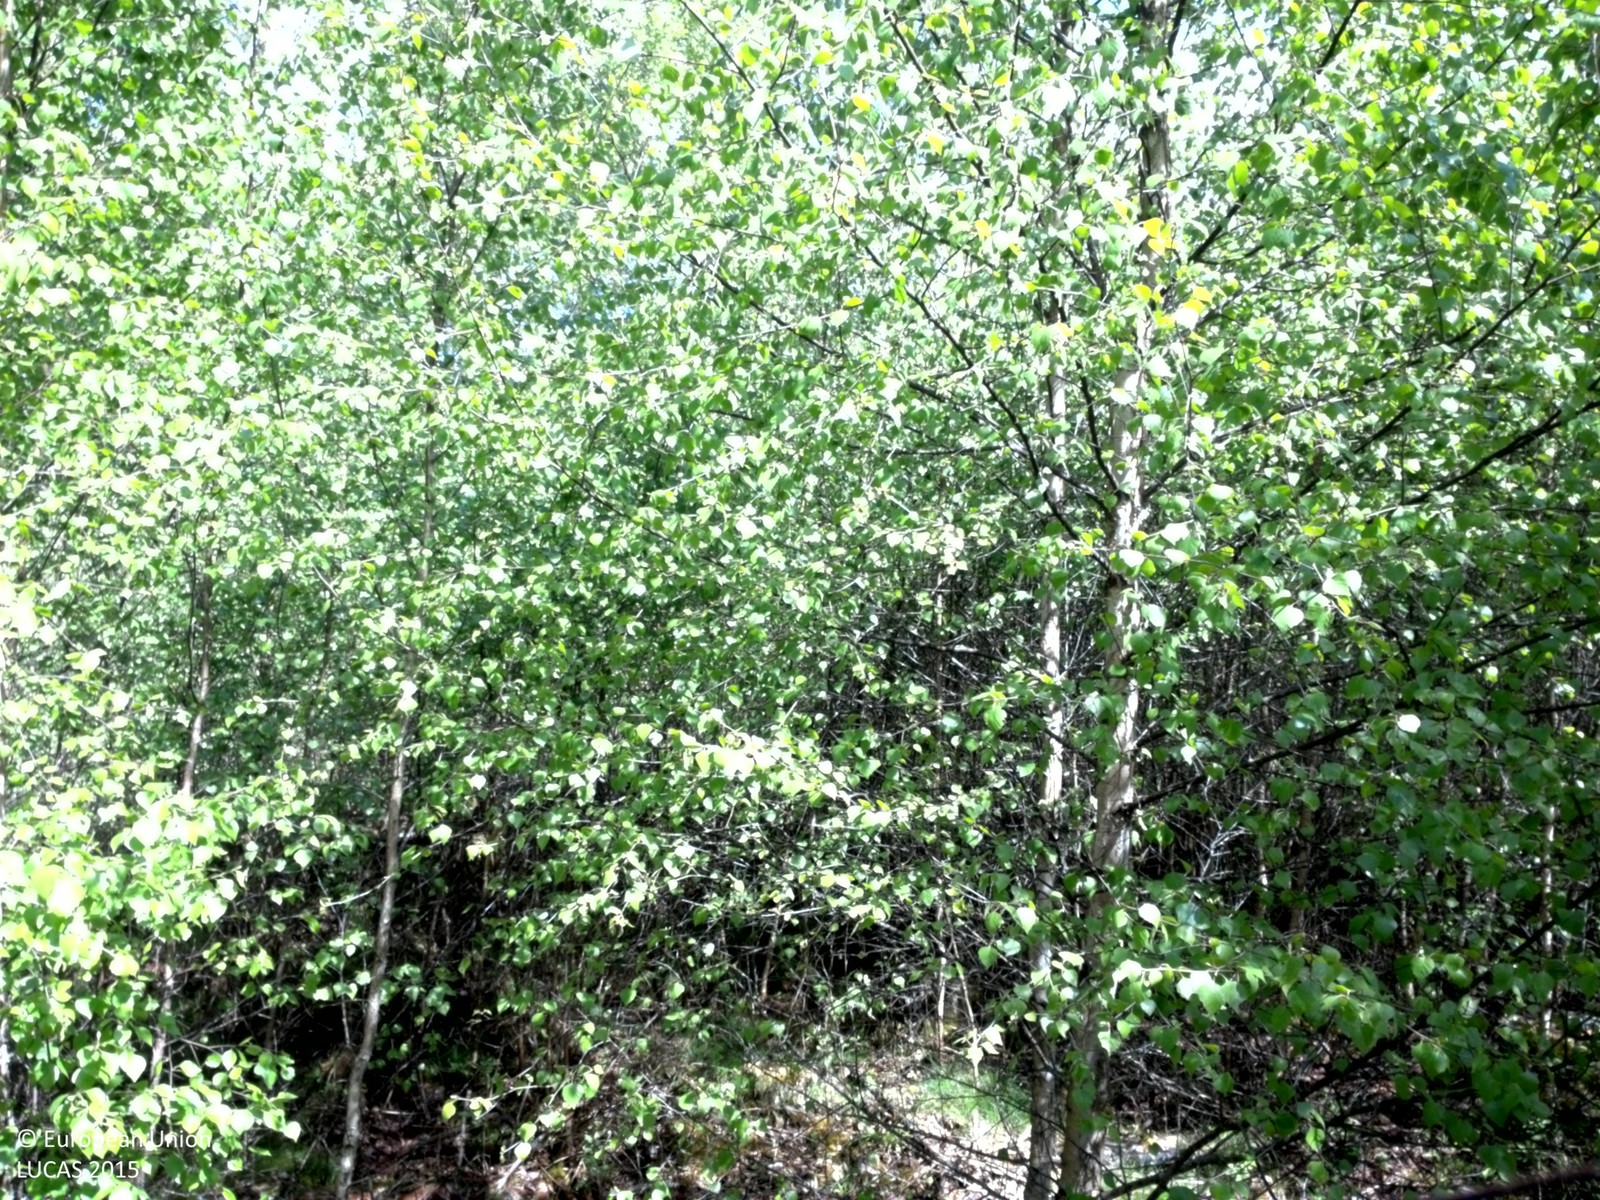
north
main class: Woodland
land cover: Broadleaved woodland
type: boreal forest
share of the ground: > 75 %
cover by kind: broadleaved forest trees 75 %, herbaceous plants 10 %, lichens and mosses 10 %, shrubs 5 %
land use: Forestry
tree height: < 5 m
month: June
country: SE
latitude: 56.7708
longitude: 14.6276
